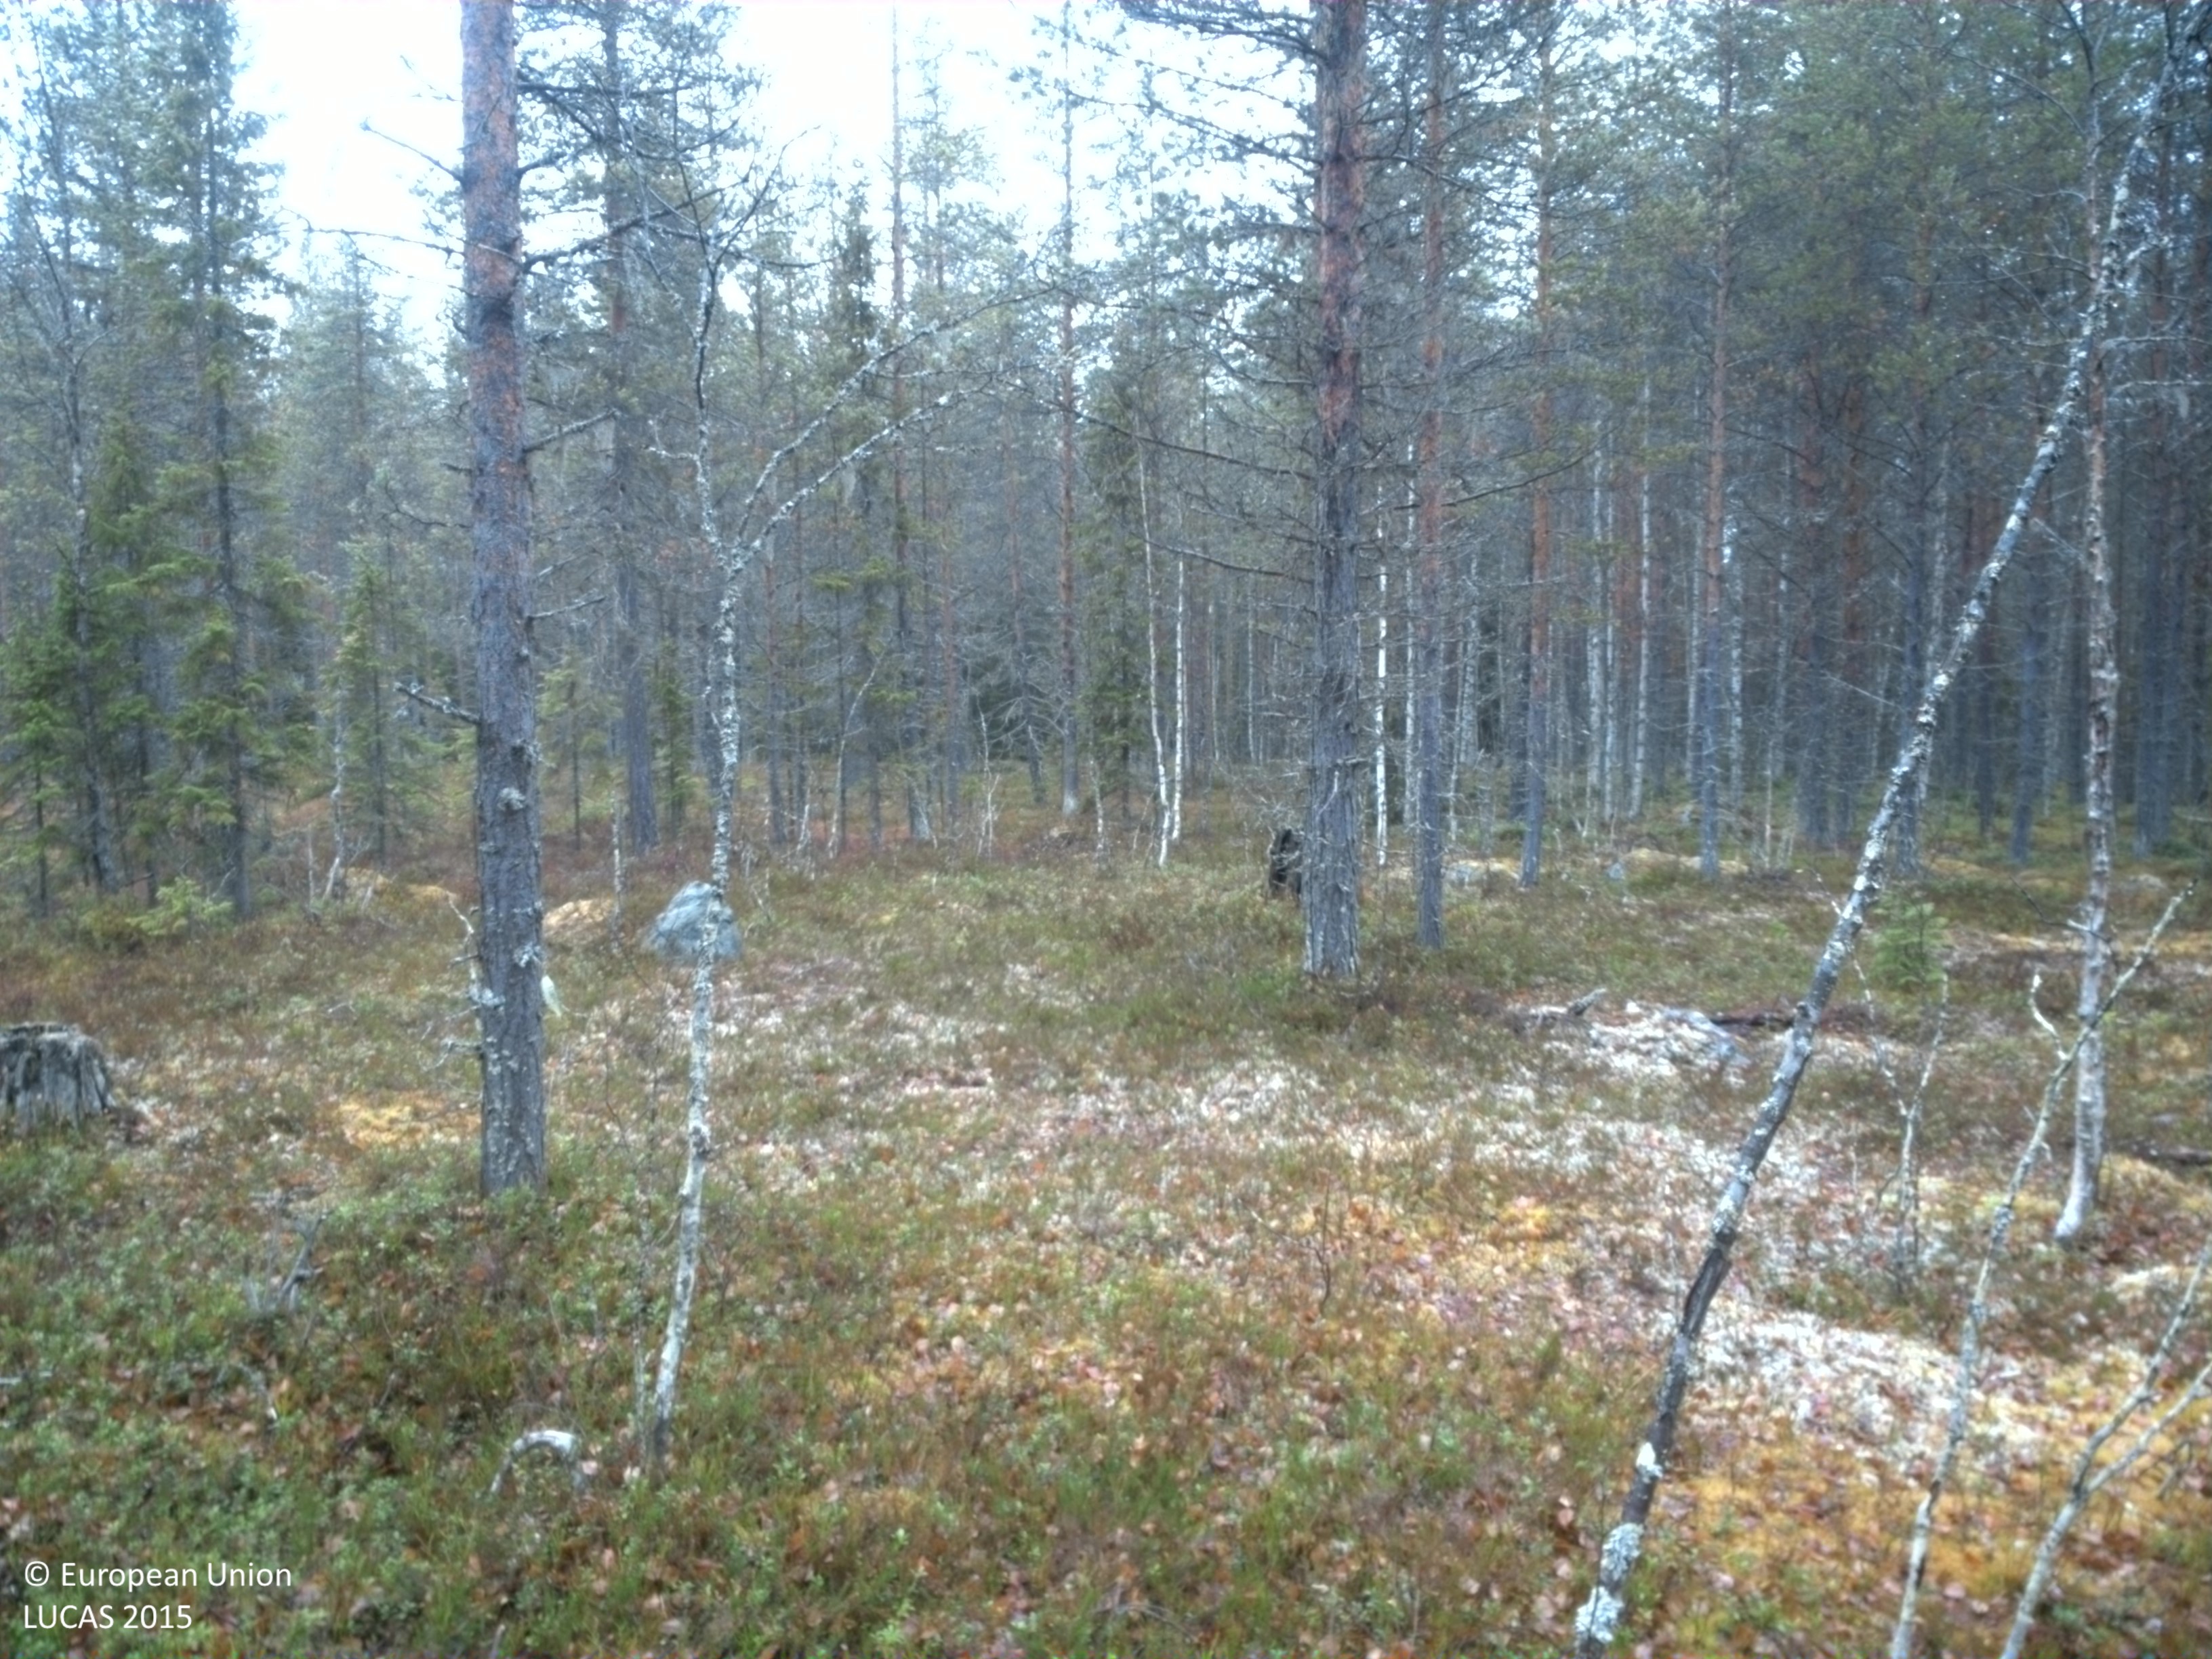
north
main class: Woodland
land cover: Pine dominated mixed woodland
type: boreal forest
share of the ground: 25 - 50 %
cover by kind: shrubs 35 %, coniferous forest trees 25 %, lichens and mosses 20 %, broadleaved forest trees 15 %, herbaceous plants 5 %
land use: Forestry
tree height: > 5 m
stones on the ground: < 10 %
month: October
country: SE
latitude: 64.4713
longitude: 16.7682
